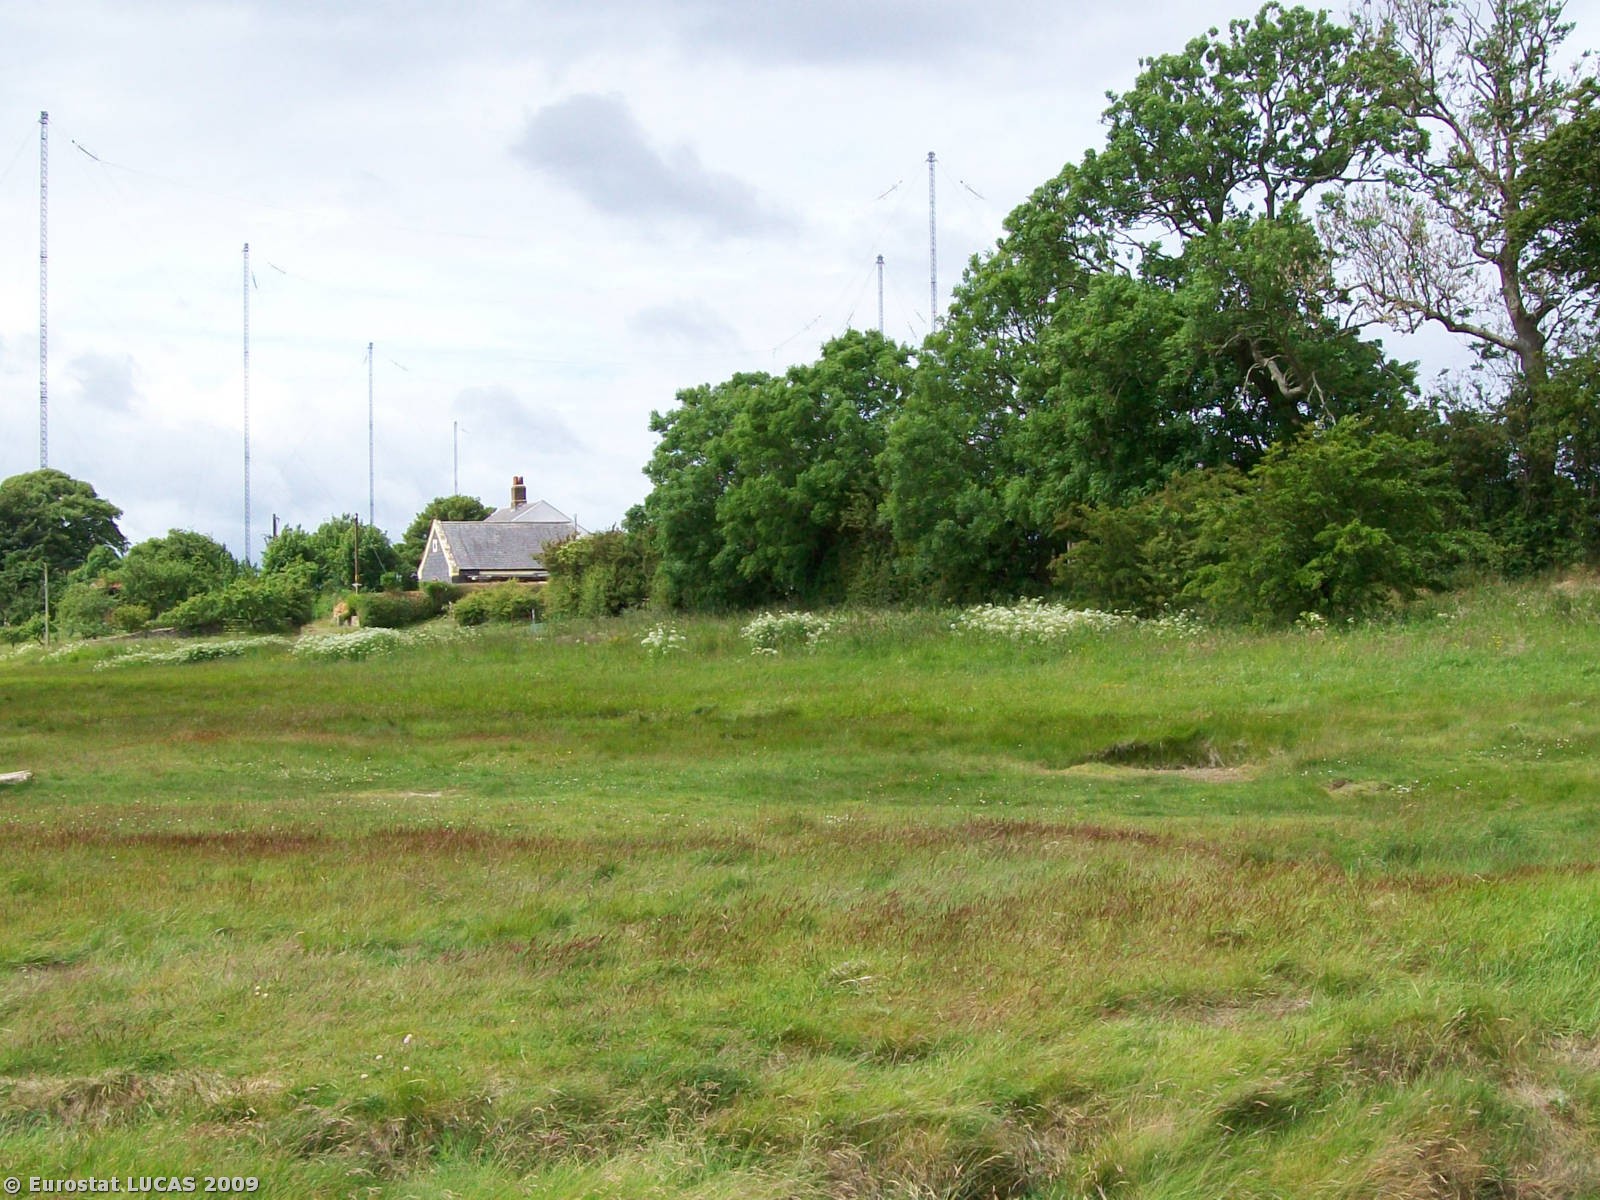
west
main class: Wetlands
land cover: Salt marshes
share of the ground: > 75 %
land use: Unused
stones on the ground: < 10 %
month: June
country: GB
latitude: 54.9120
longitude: -3.2572
